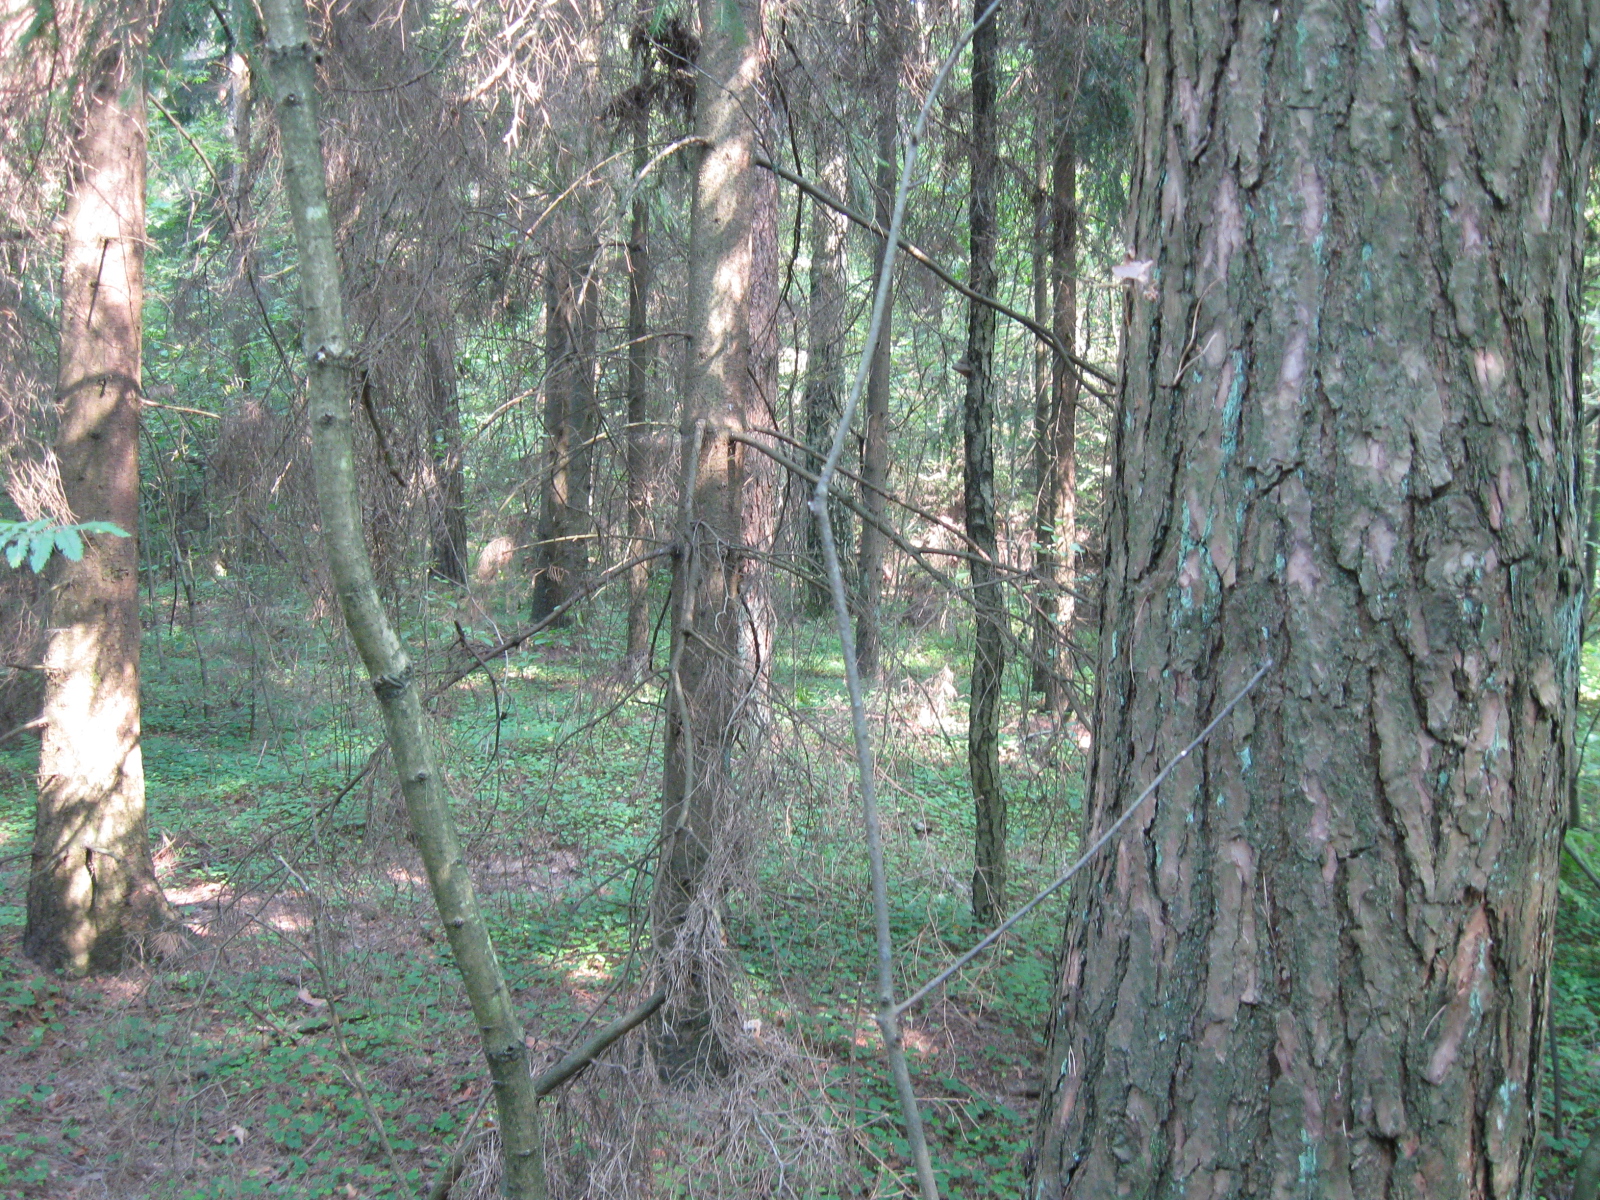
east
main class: Woodland
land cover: Pine dominated coniferous woodland
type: hemiboreal forest and nemoral coniferous forest and mixed broadleaved-coniferous forest
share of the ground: > 75 %
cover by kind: coniferous forest trees 80 %, broadleaved forest trees 15 %, shrubs 5 %
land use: Forestry
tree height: > 5 m
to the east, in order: Pine dominated coniferous woodland; Spruce dominated coniferous woodland; Tracks; Other coniferous woodland
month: August
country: LT
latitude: 54.7546
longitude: 23.3638
